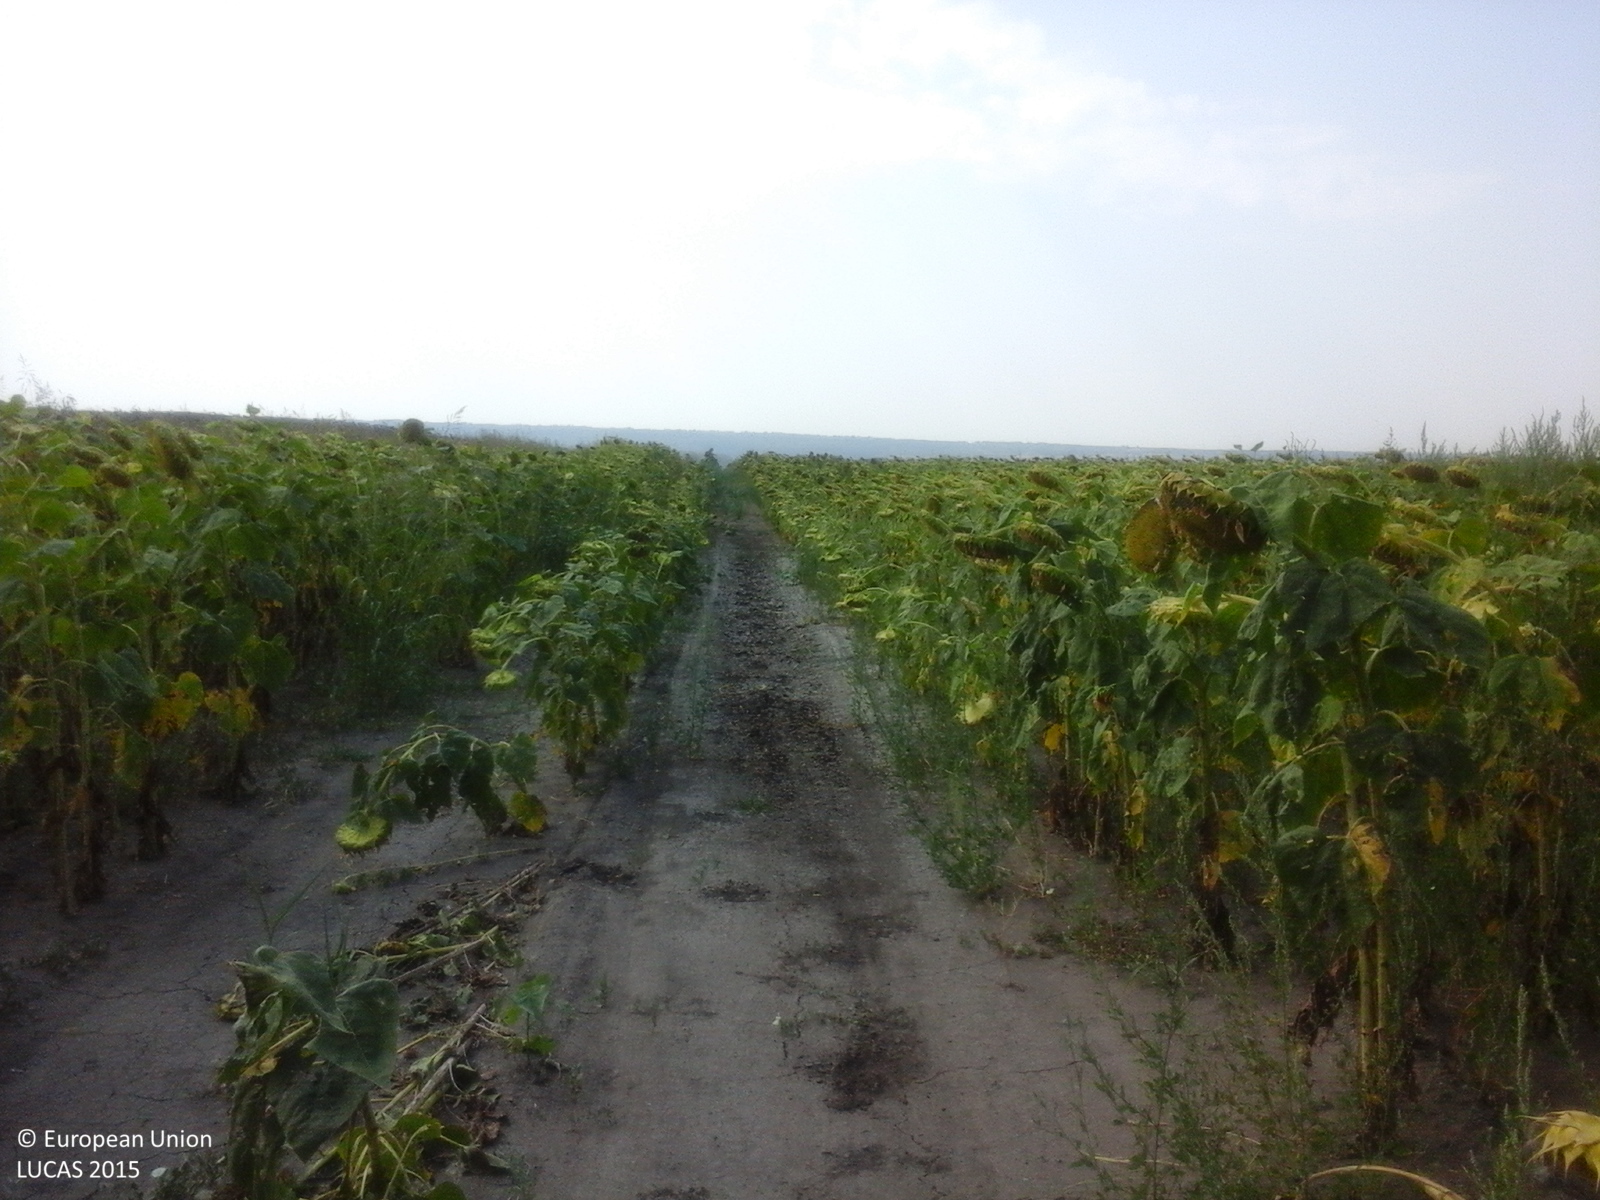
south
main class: Cropland
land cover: Sunflower
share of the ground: > 75 %
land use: Agriculture (excluding fallow land and kitchen gardens)
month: August
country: RO
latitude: 43.8787
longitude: 23.4005
